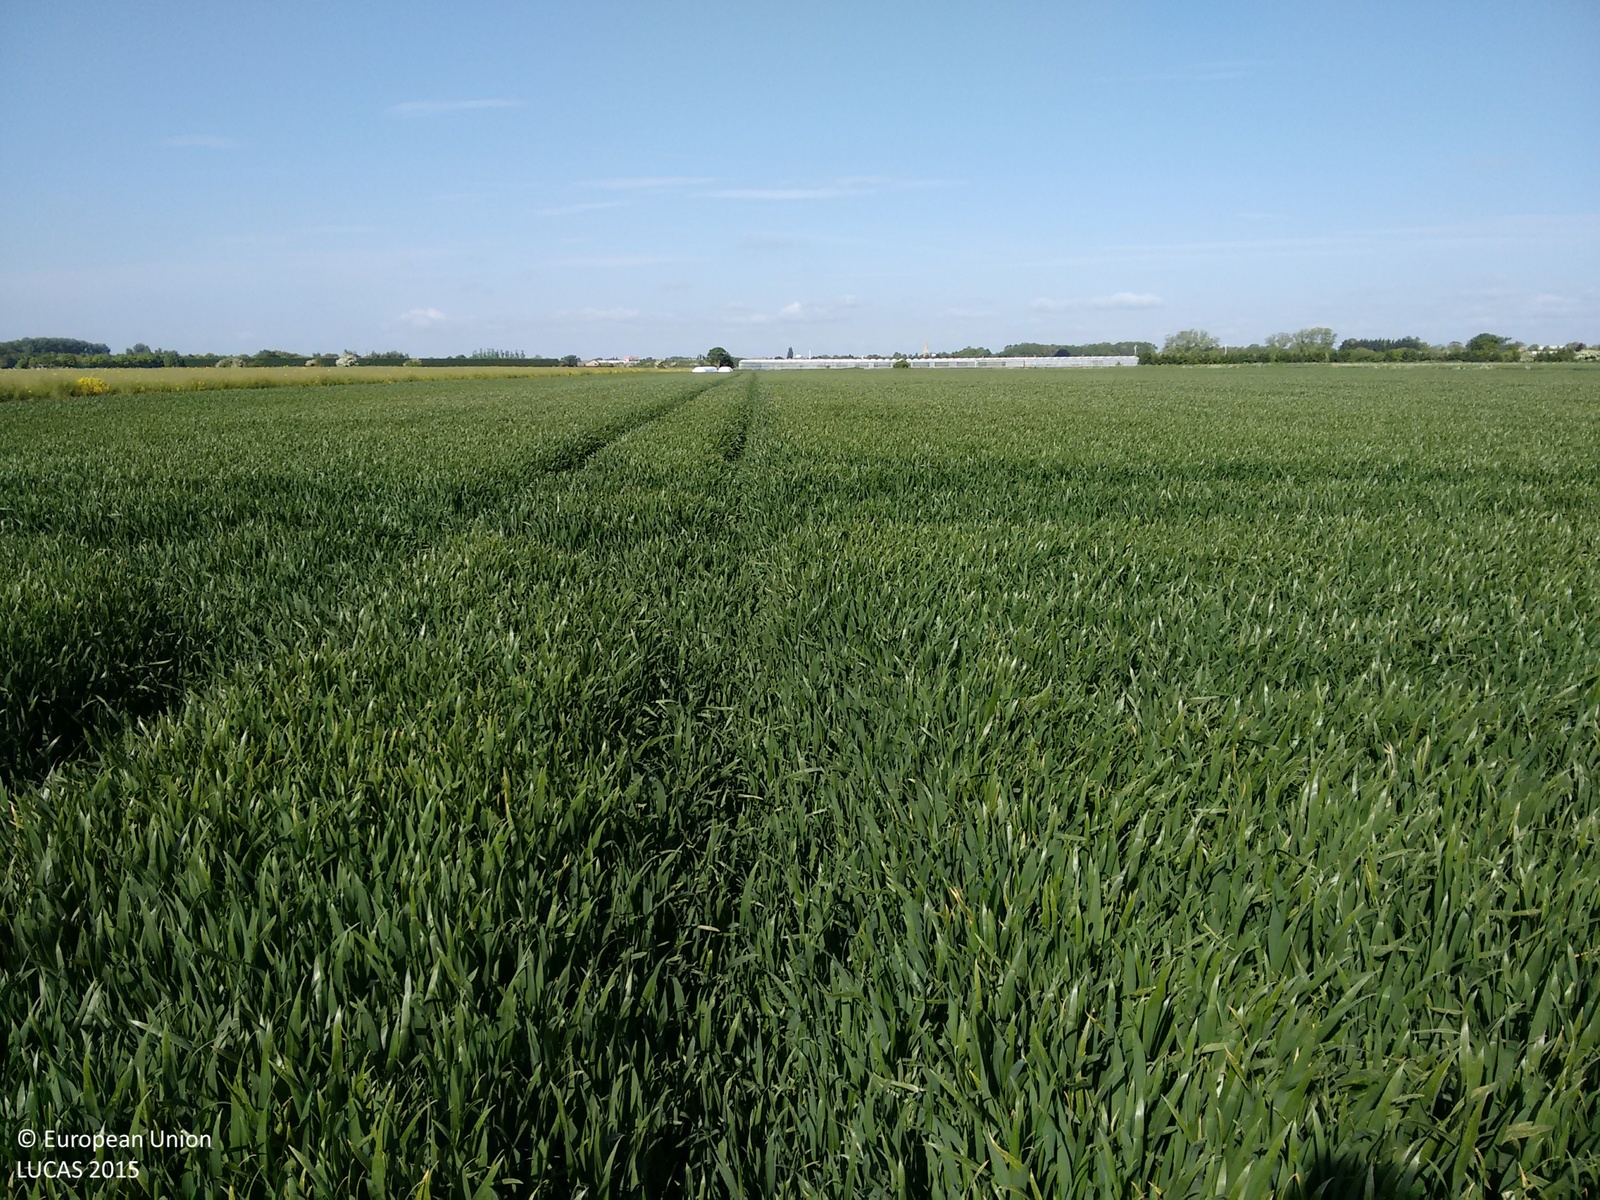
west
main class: Cropland
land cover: Common wheat
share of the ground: > 75 %
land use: Agriculture (excluding fallow land and kitchen gardens)
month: May
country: GB
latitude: 52.7971
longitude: -0.1037
